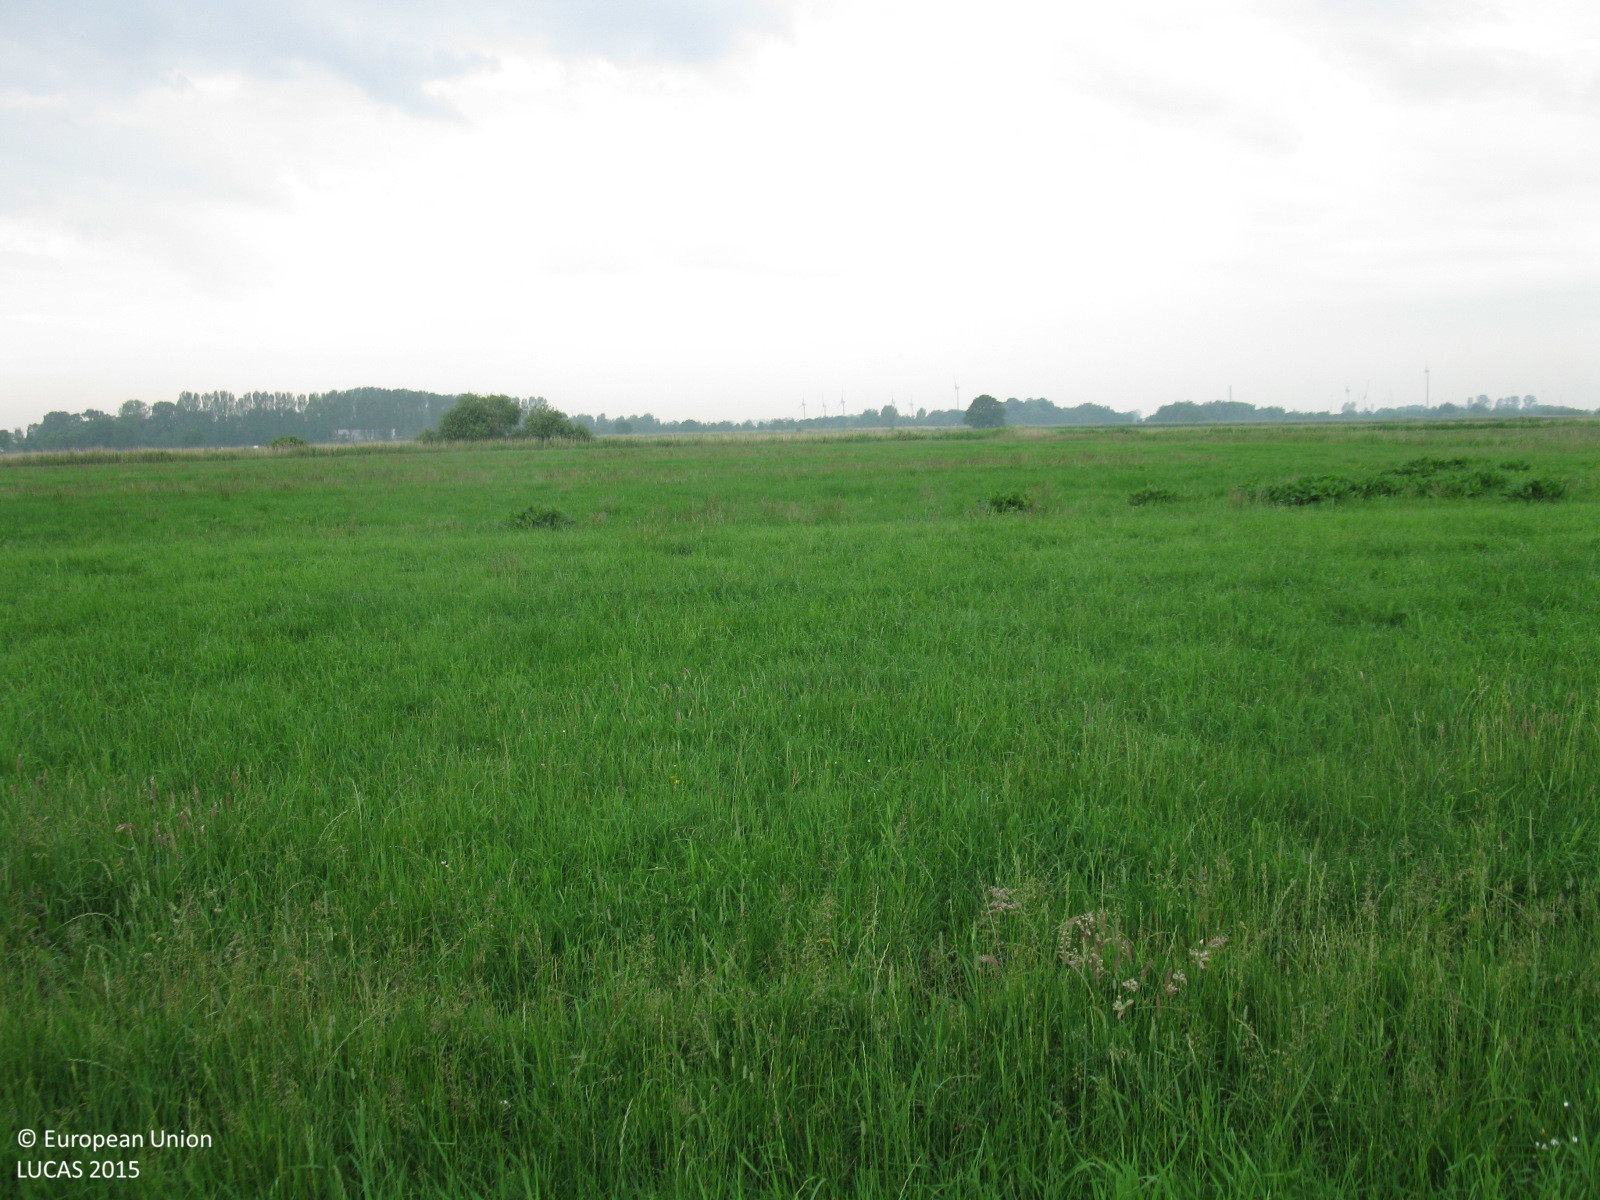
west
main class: Grassland
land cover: Grassland without tree/shrub cover
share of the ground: > 75 %
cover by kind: herbaceous plants 100 %
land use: Agriculture (excluding fallow land and kitchen gardens)
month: June
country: DE
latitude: 53.5810
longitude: 7.8710
